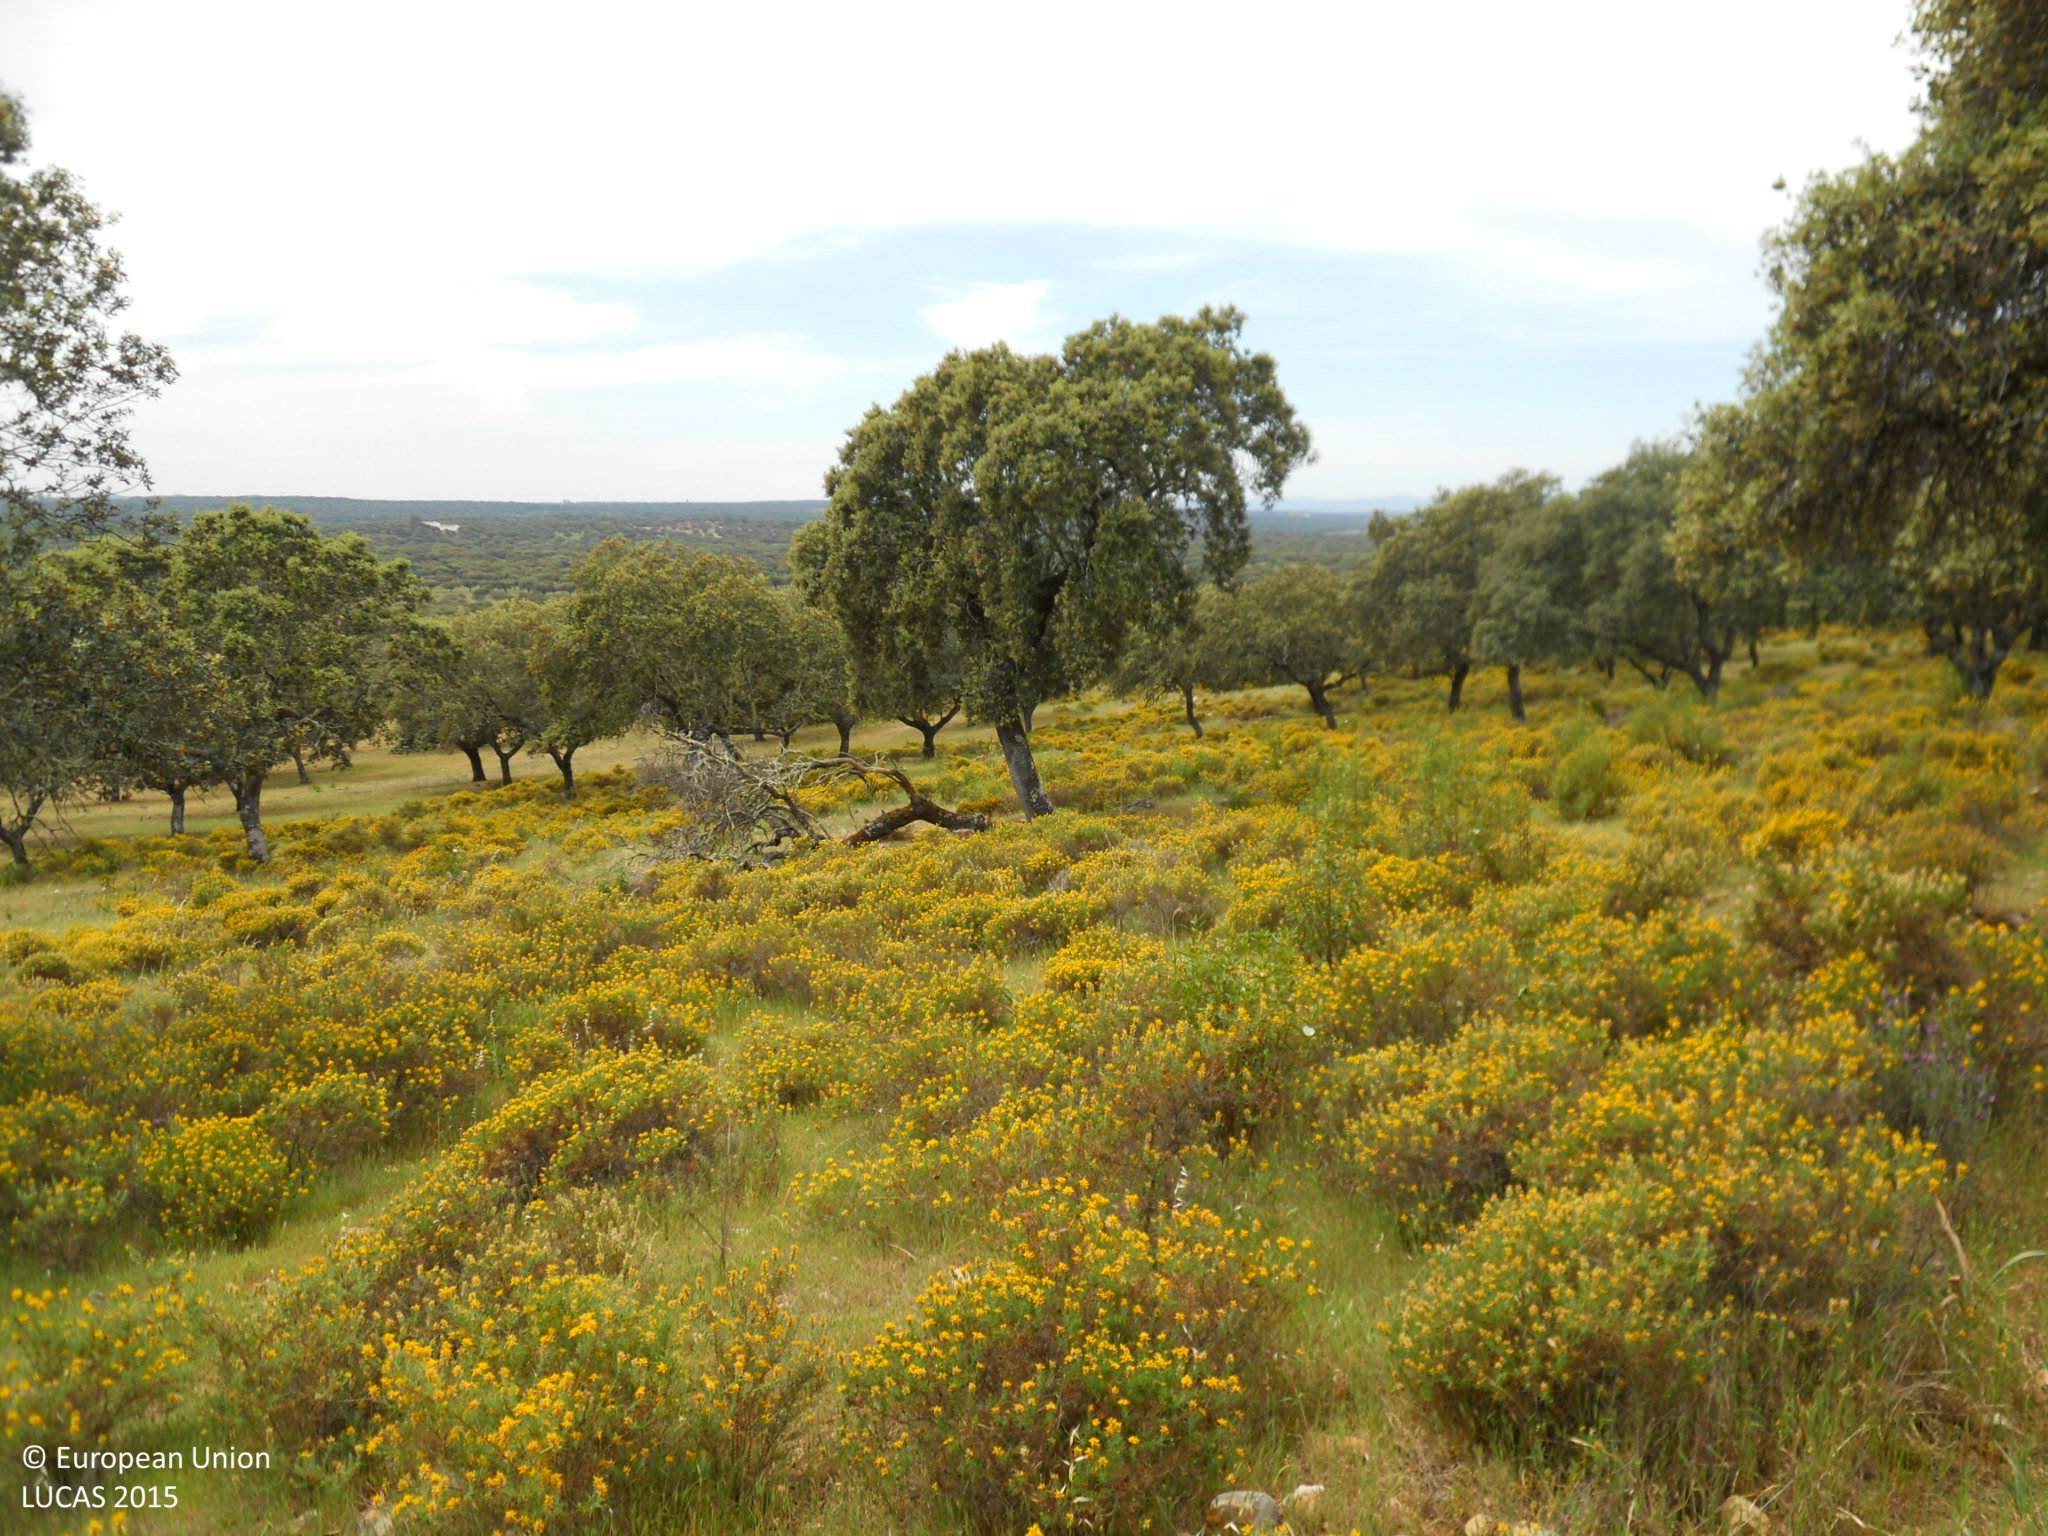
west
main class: Woodland
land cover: Broadleaved woodland
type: broadleaved evergreen forest
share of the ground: 25 - 50 %
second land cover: Shrubland without tree cover
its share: > 75 %
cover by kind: broadleaved forest trees 90 %, shrubs 5 %, herbaceous plants 5 %
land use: Forestry
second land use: Agriculture (excluding fallow land and kitchen gardens)
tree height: > 5 m
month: April
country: ES
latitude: 39.3266
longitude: -6.8848
